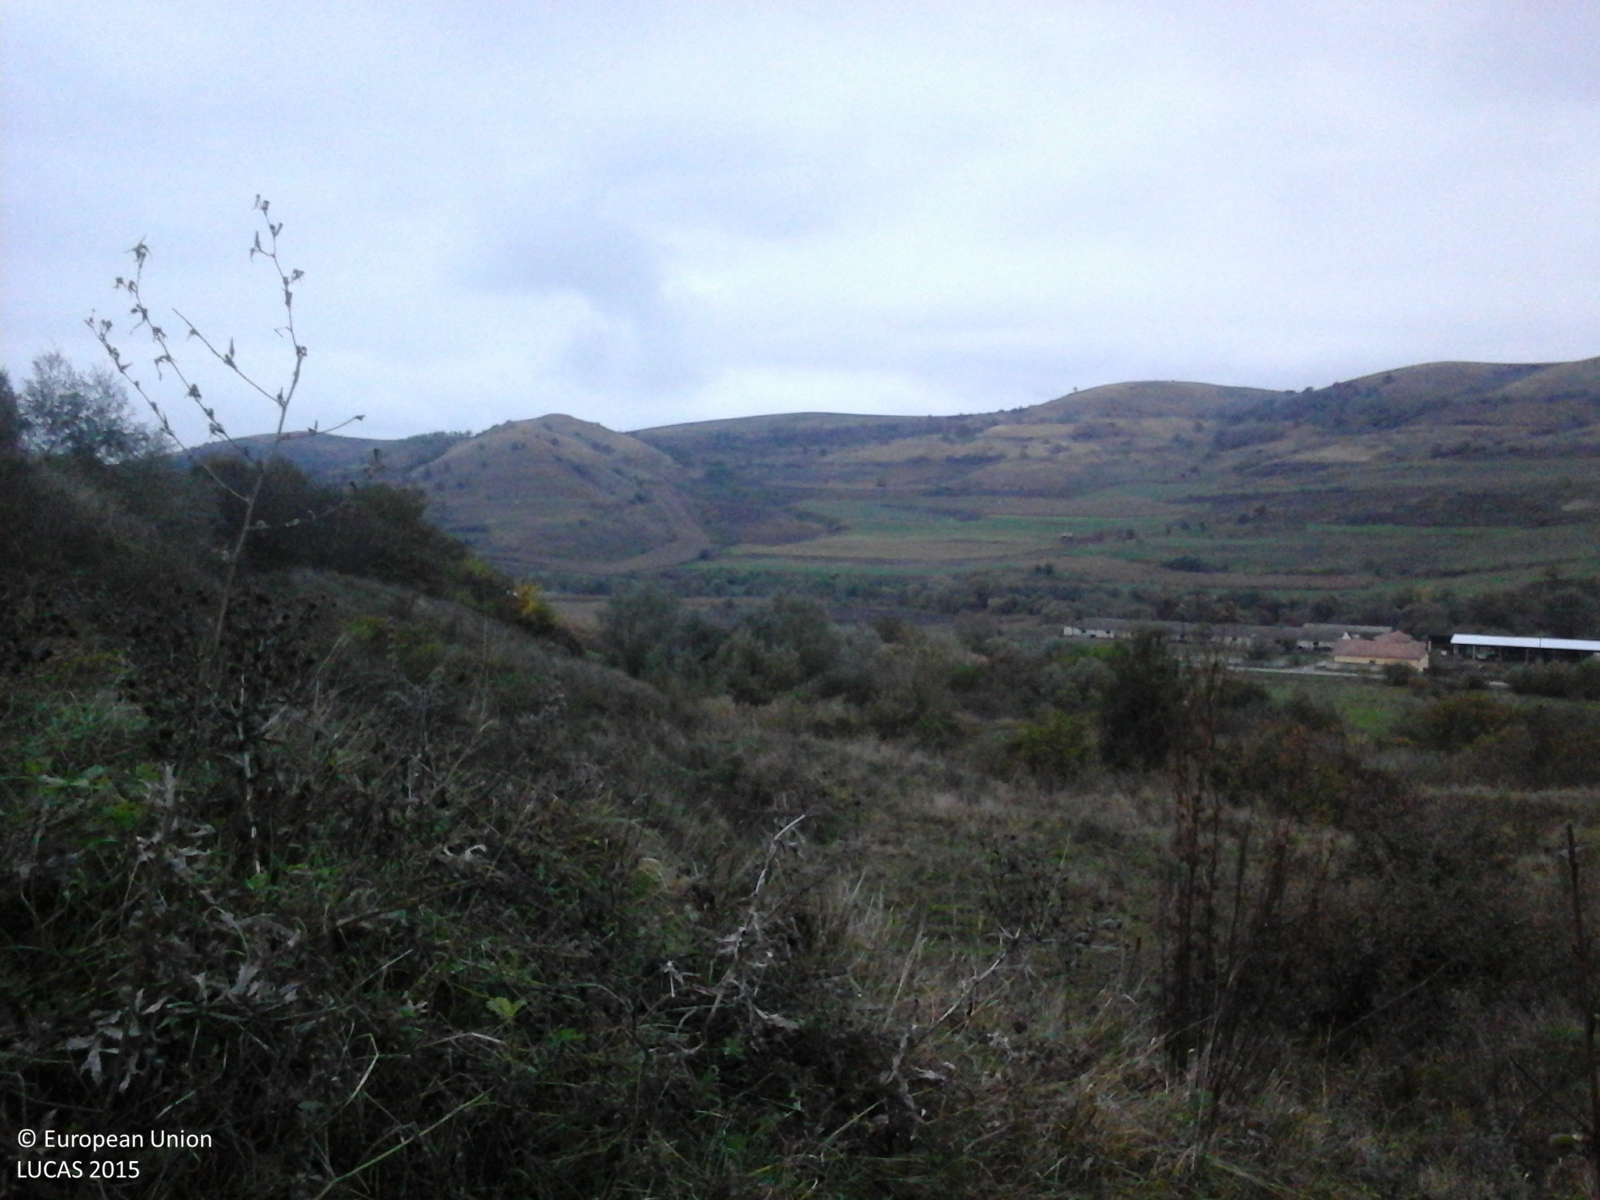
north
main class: Grassland
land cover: Grassland with sparse tree/shrub cover
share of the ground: > 75 %
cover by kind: herbaceous plants 85 %, shrubs 10 %, broadleaved forest trees 5 %
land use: Agriculture (excluding fallow land and kitchen gardens)
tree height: > 5 m
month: October
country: RO
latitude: 45.9175
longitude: 24.1422
